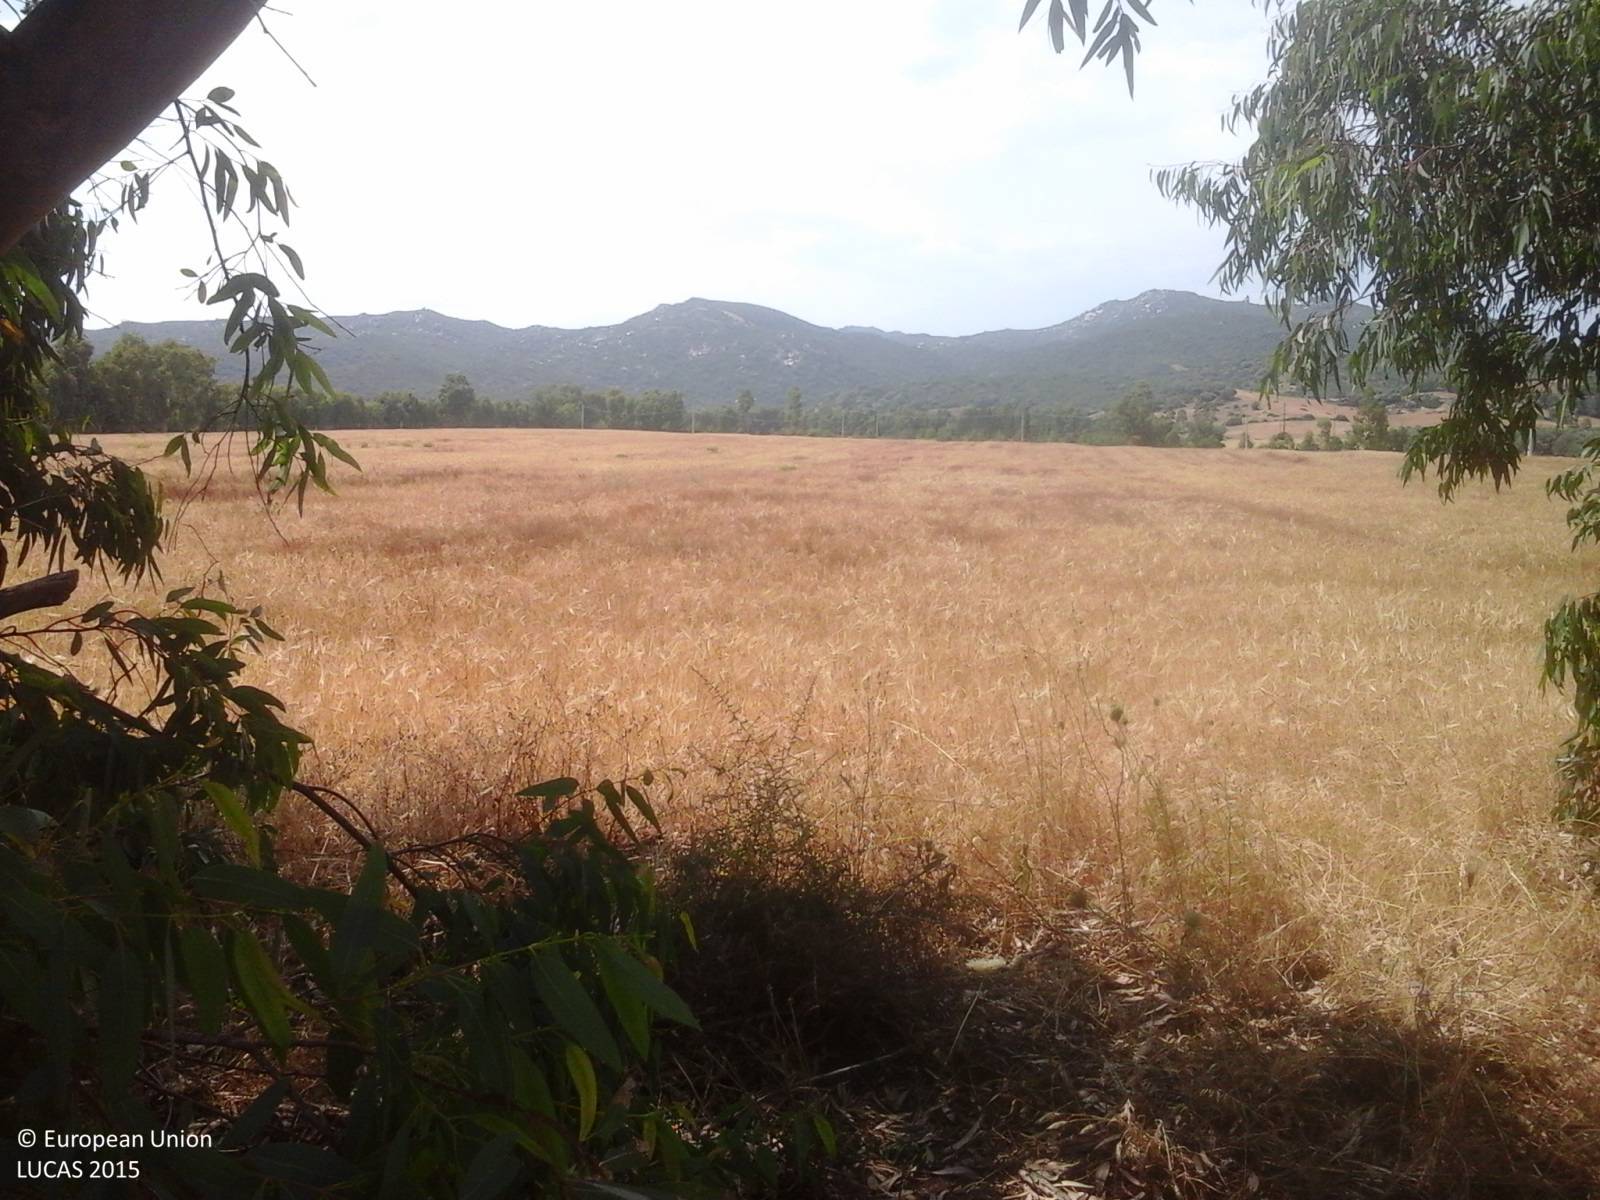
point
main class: Cropland
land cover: Common wheat
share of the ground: > 75 %
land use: Agriculture (excluding fallow land and kitchen gardens)
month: June
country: IT
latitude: 39.2885
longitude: 9.5967
